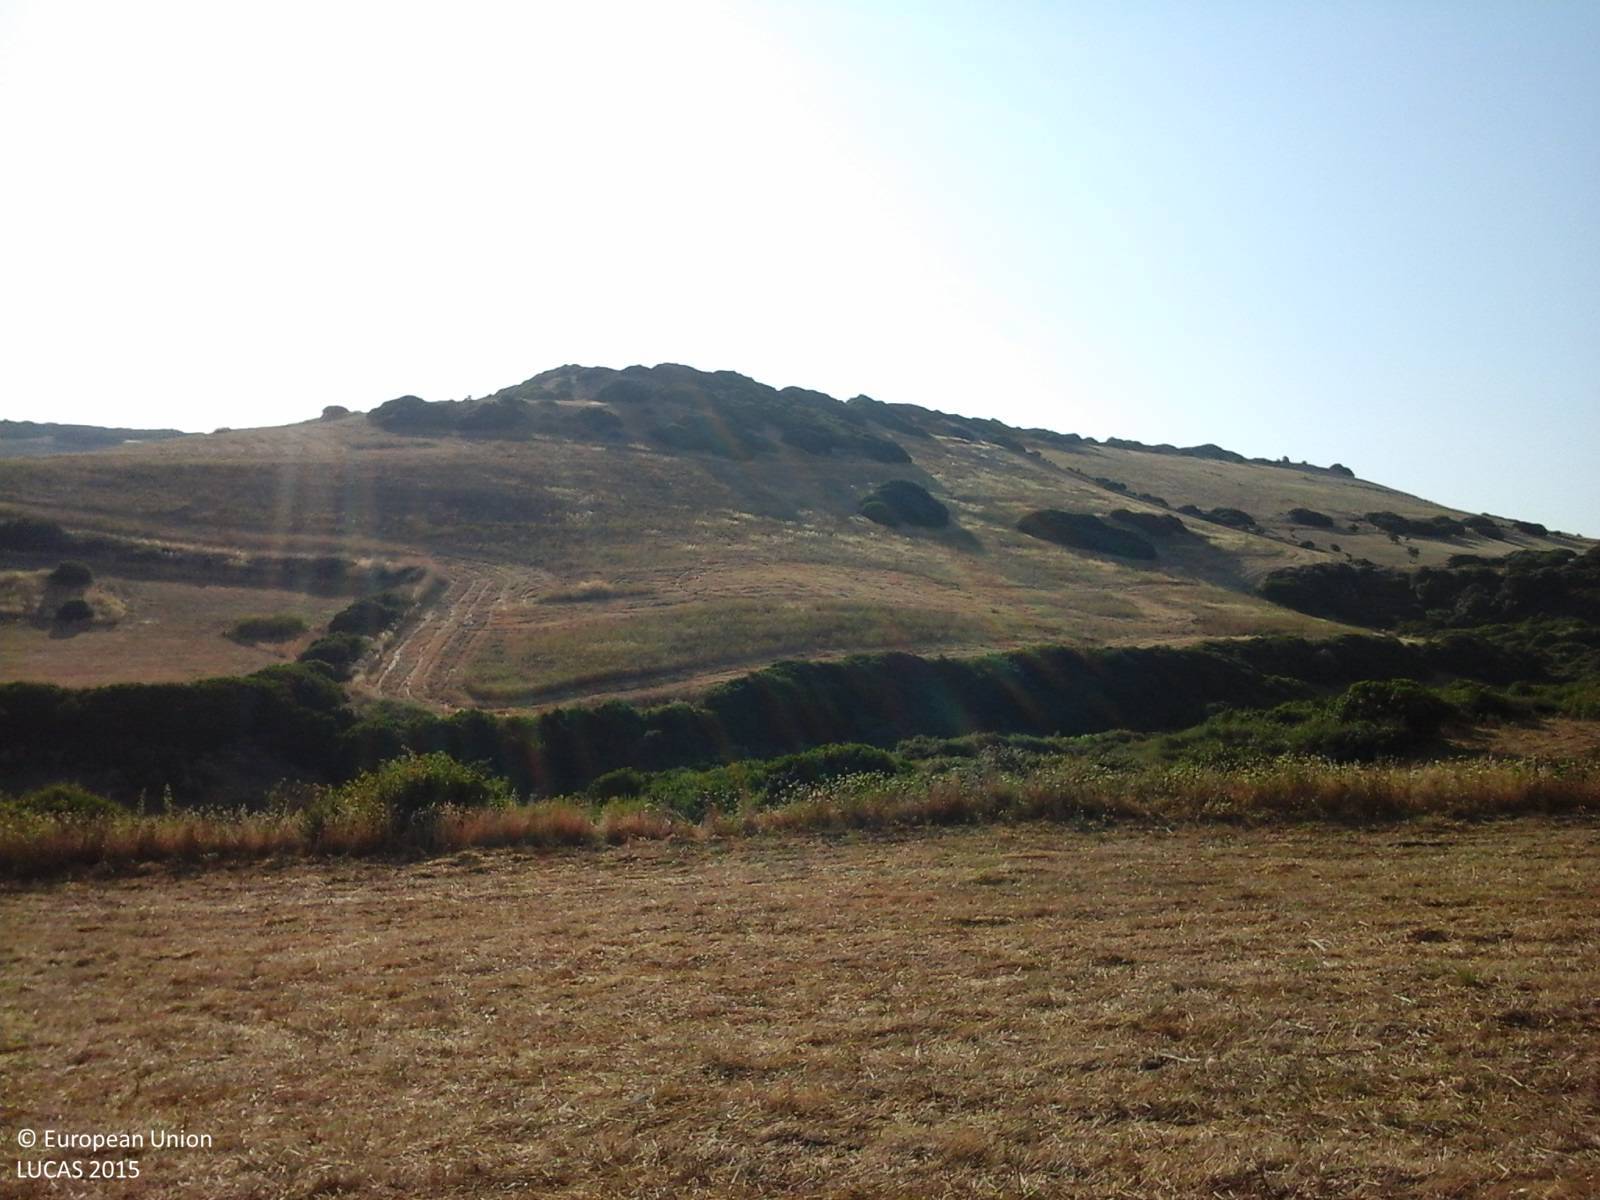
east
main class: Cropland
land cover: Oats
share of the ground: > 75 %
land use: Agriculture (excluding fallow land and kitchen gardens)
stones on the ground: < 10 %
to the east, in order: Oats; Dry stone walls; Fences; Abandoned hedges; Grassland without tree/shrub cover; Shrubland without tree cover; Grassland without tree/shrub cover; Shrubland without tree cover; Spontaneously vegetated surfaces
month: July
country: IT
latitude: 40.7672
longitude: 8.8328
